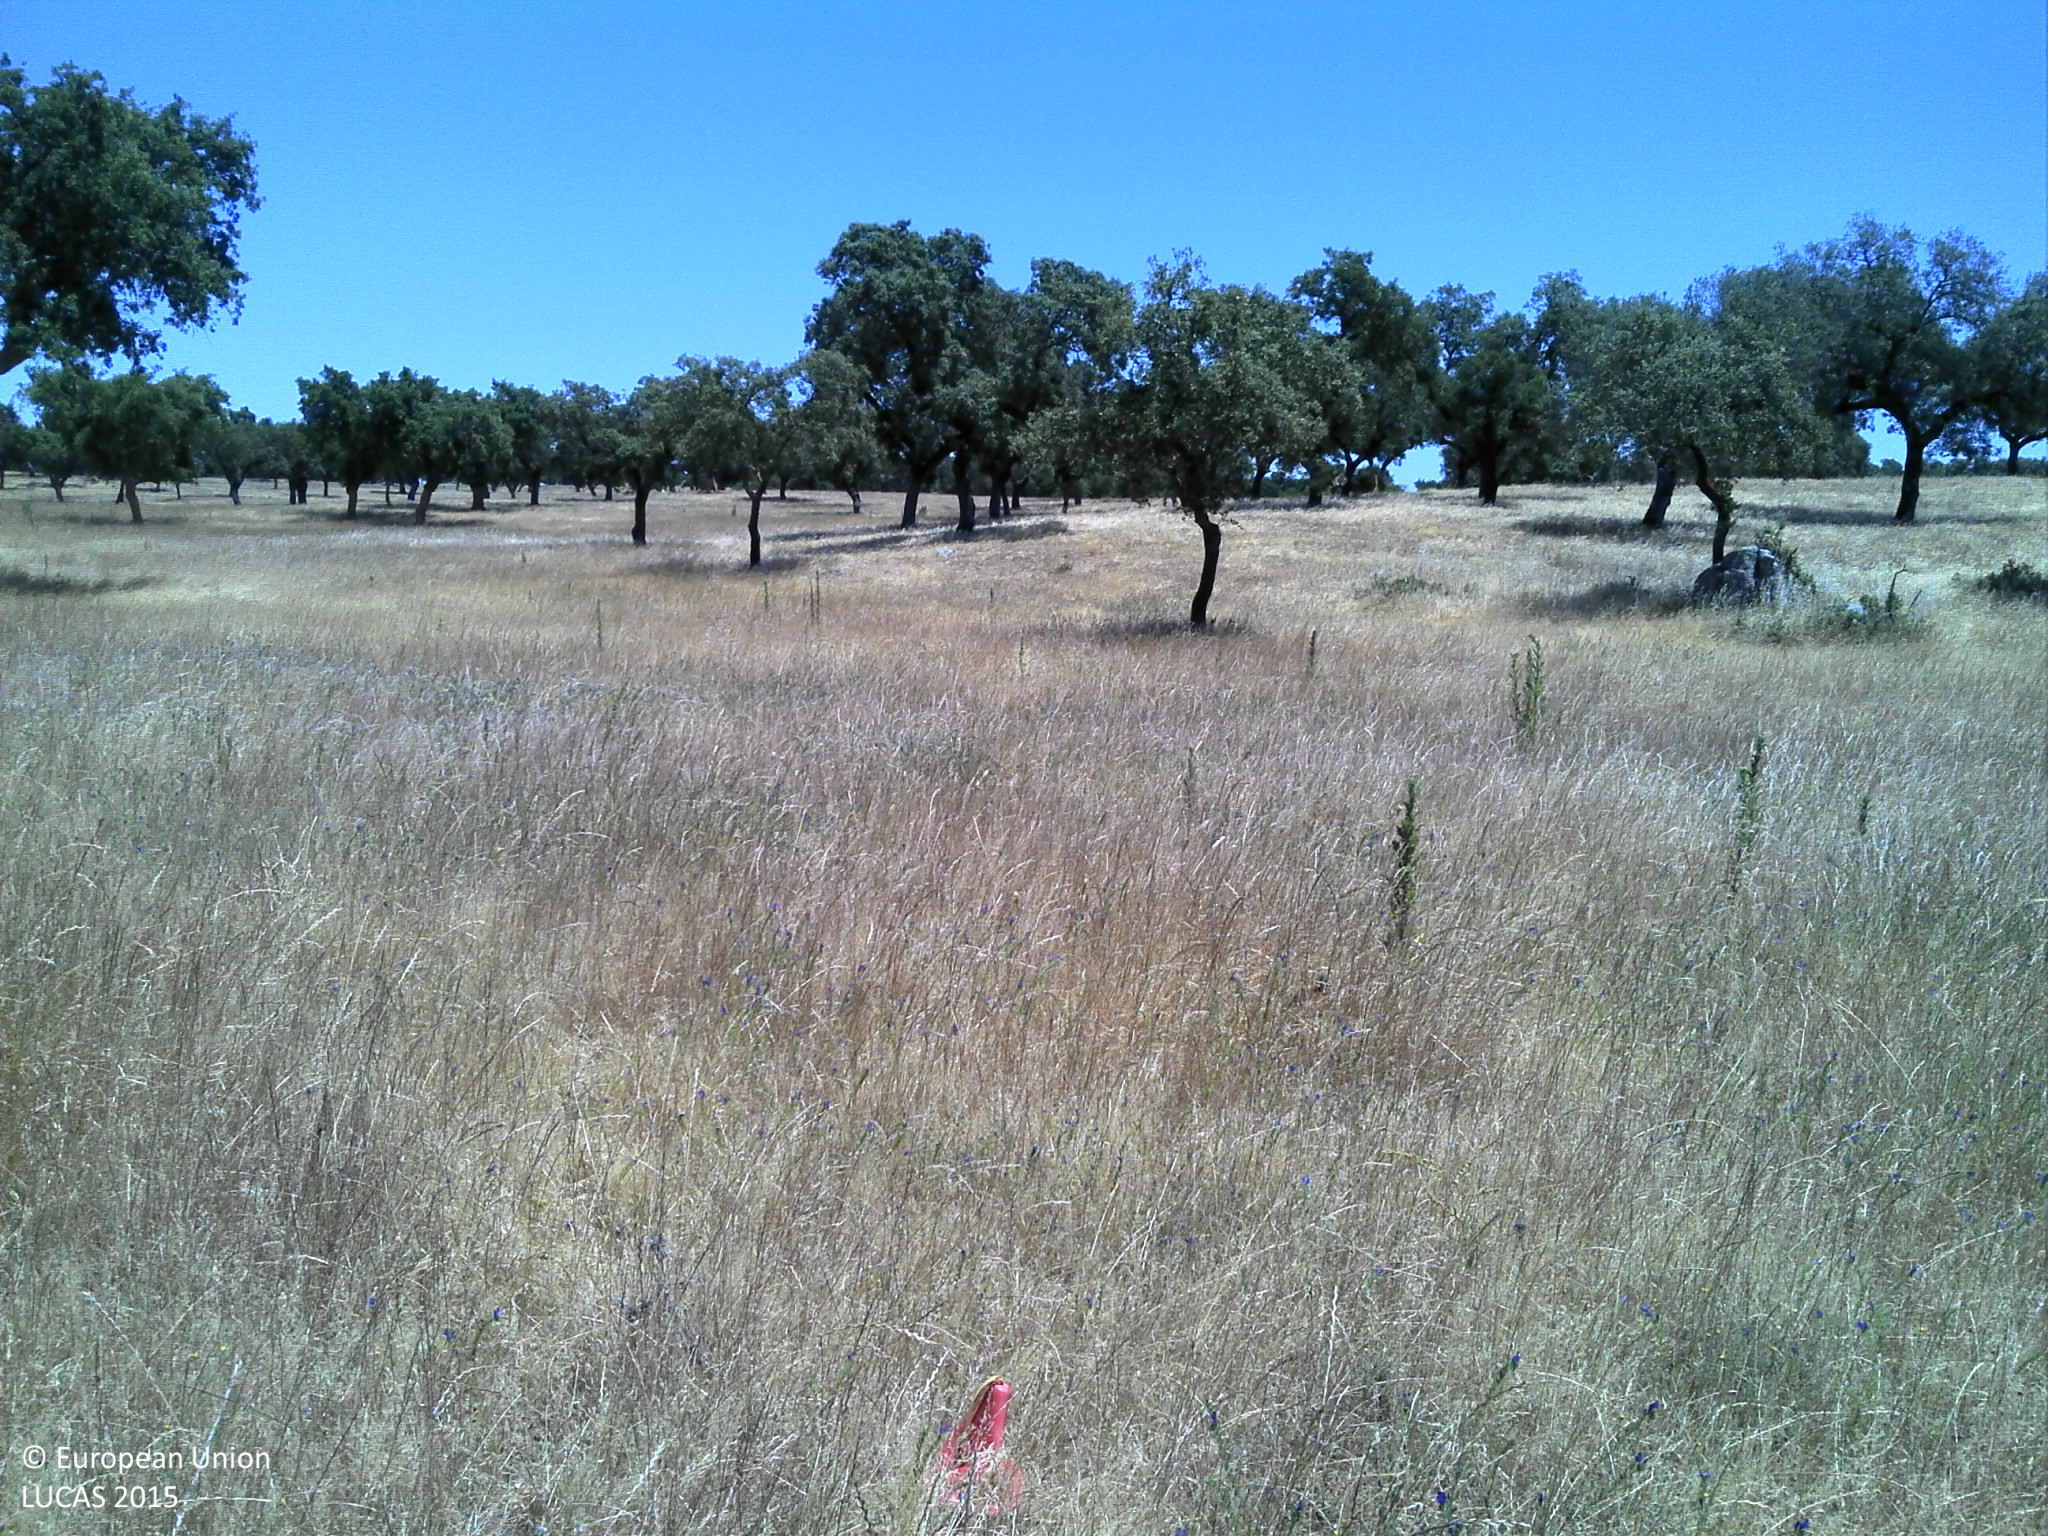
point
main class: Grassland
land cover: Grassland without tree/shrub cover
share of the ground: > 75 %
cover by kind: herbaceous plants 90 %, unconsolidated bare surface 10 %
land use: Agriculture (excluding fallow land and kitchen gardens)
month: May
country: PT
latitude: 38.8094
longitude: -8.0940
